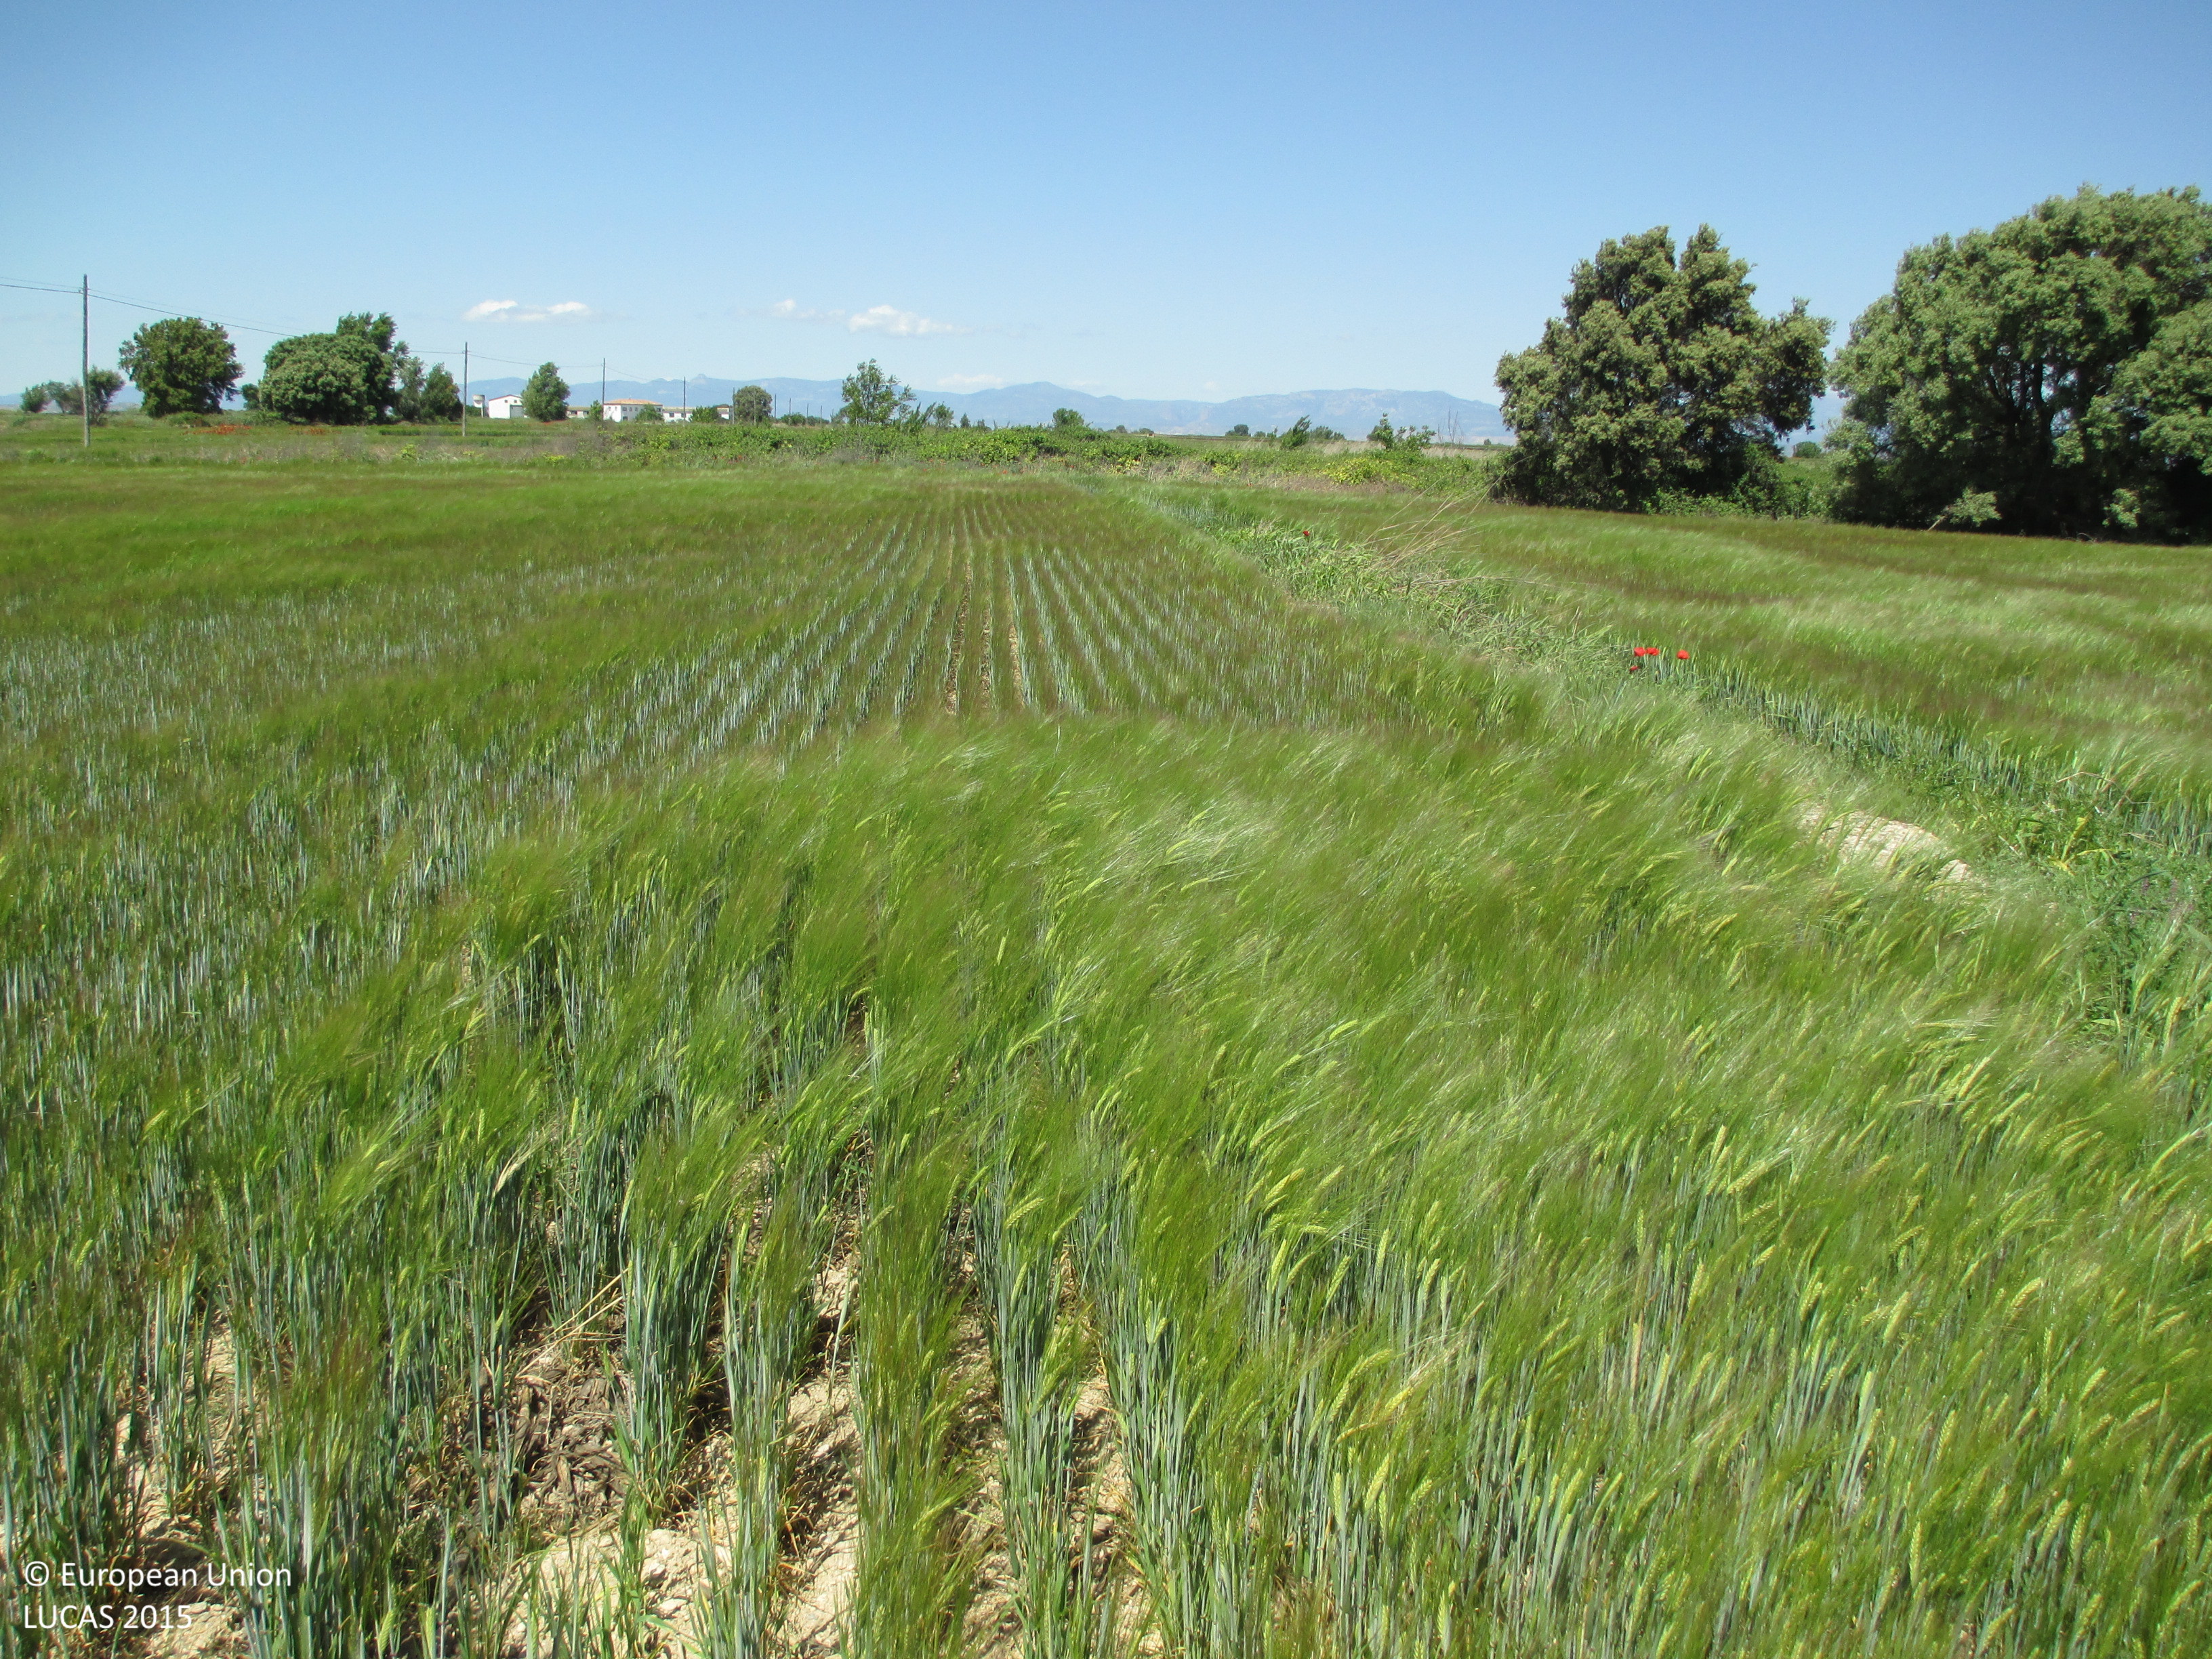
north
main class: Cropland
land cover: Barley
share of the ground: > 75 %
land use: Agriculture (excluding fallow land and kitchen gardens)
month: May
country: ES
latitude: 41.9680
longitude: -0.4349
